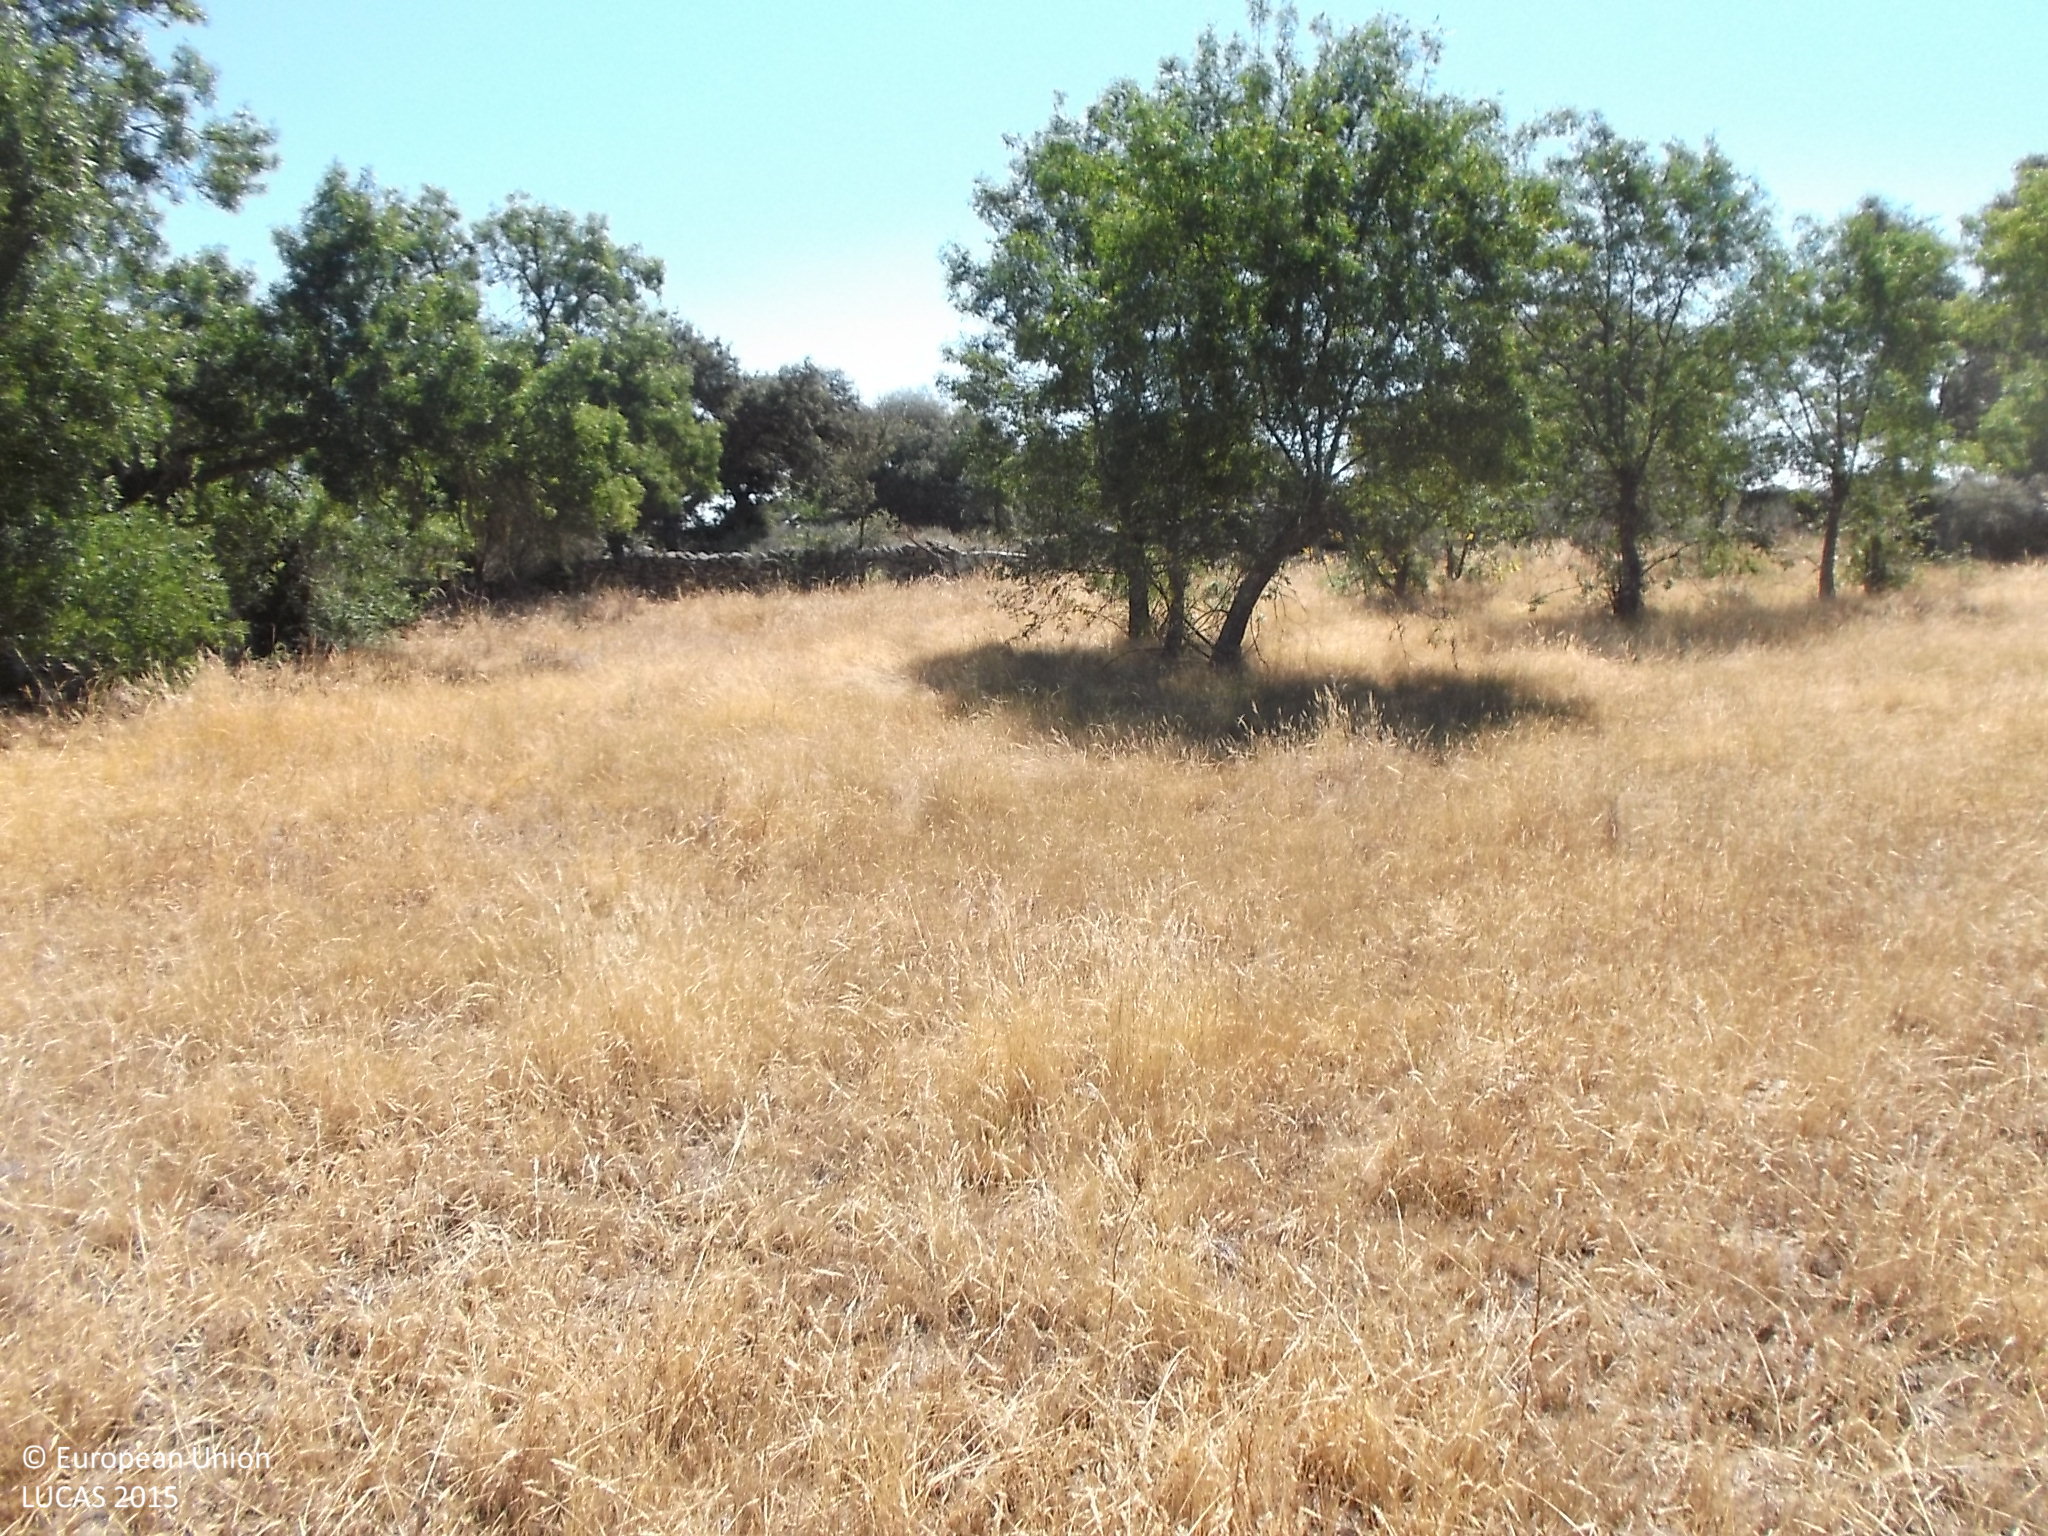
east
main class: Grassland
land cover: Grassland with sparse tree/shrub cover
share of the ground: > 75 %
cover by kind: herbaceous plants 90 %, broadleaved forest trees 5 %, shrubs 5 %
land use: Agriculture (excluding fallow land and kitchen gardens)
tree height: < 5 m
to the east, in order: Grassland with sparse tree/shrub cover; Dry stone walls; Shrubland with sparse tree cover; Dry stone walls; Shruby margins; Tracks; Groves; Dry stone walls; Shruby margins; Dry stone walls; Groves
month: June
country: ES
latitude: 40.8972
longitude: -6.7531
